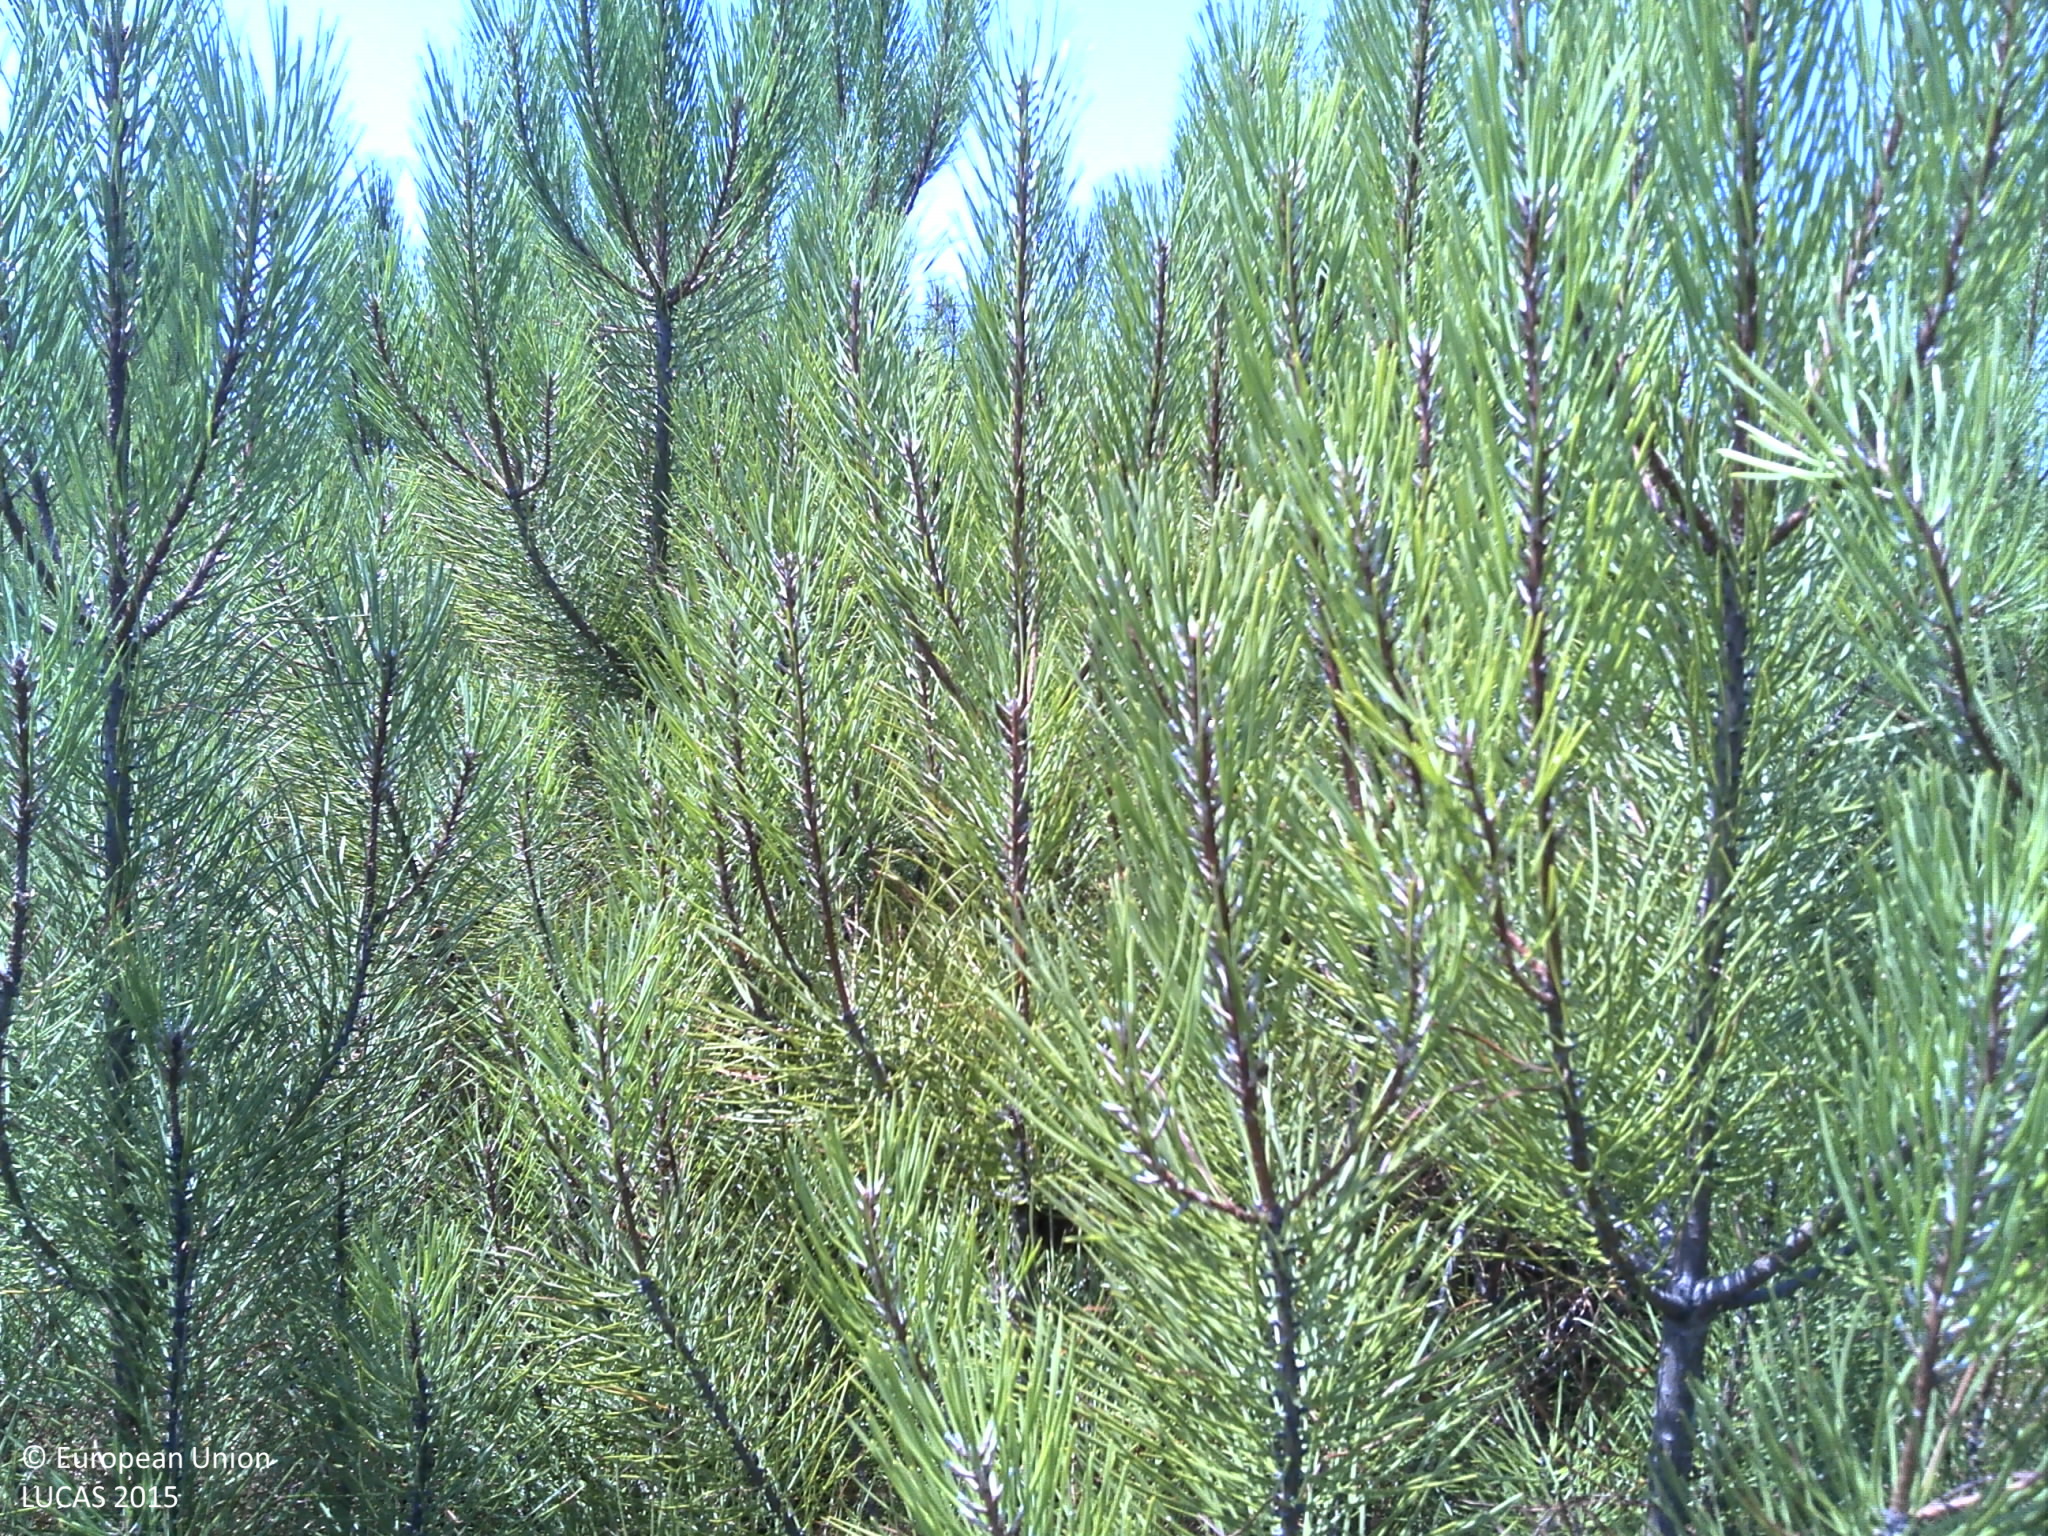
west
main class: Woodland
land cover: Pine dominated coniferous woodland
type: coniferous forest of the mediterranean region
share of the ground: 25 - 50 %
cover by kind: shrubs 60 %, coniferous forest trees 30 %, unconsolidated bare surface 10 %
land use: Forestry
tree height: < 5 m
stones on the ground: 10 - 25 %
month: July
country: PT
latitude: 40.8182
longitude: -7.9232
